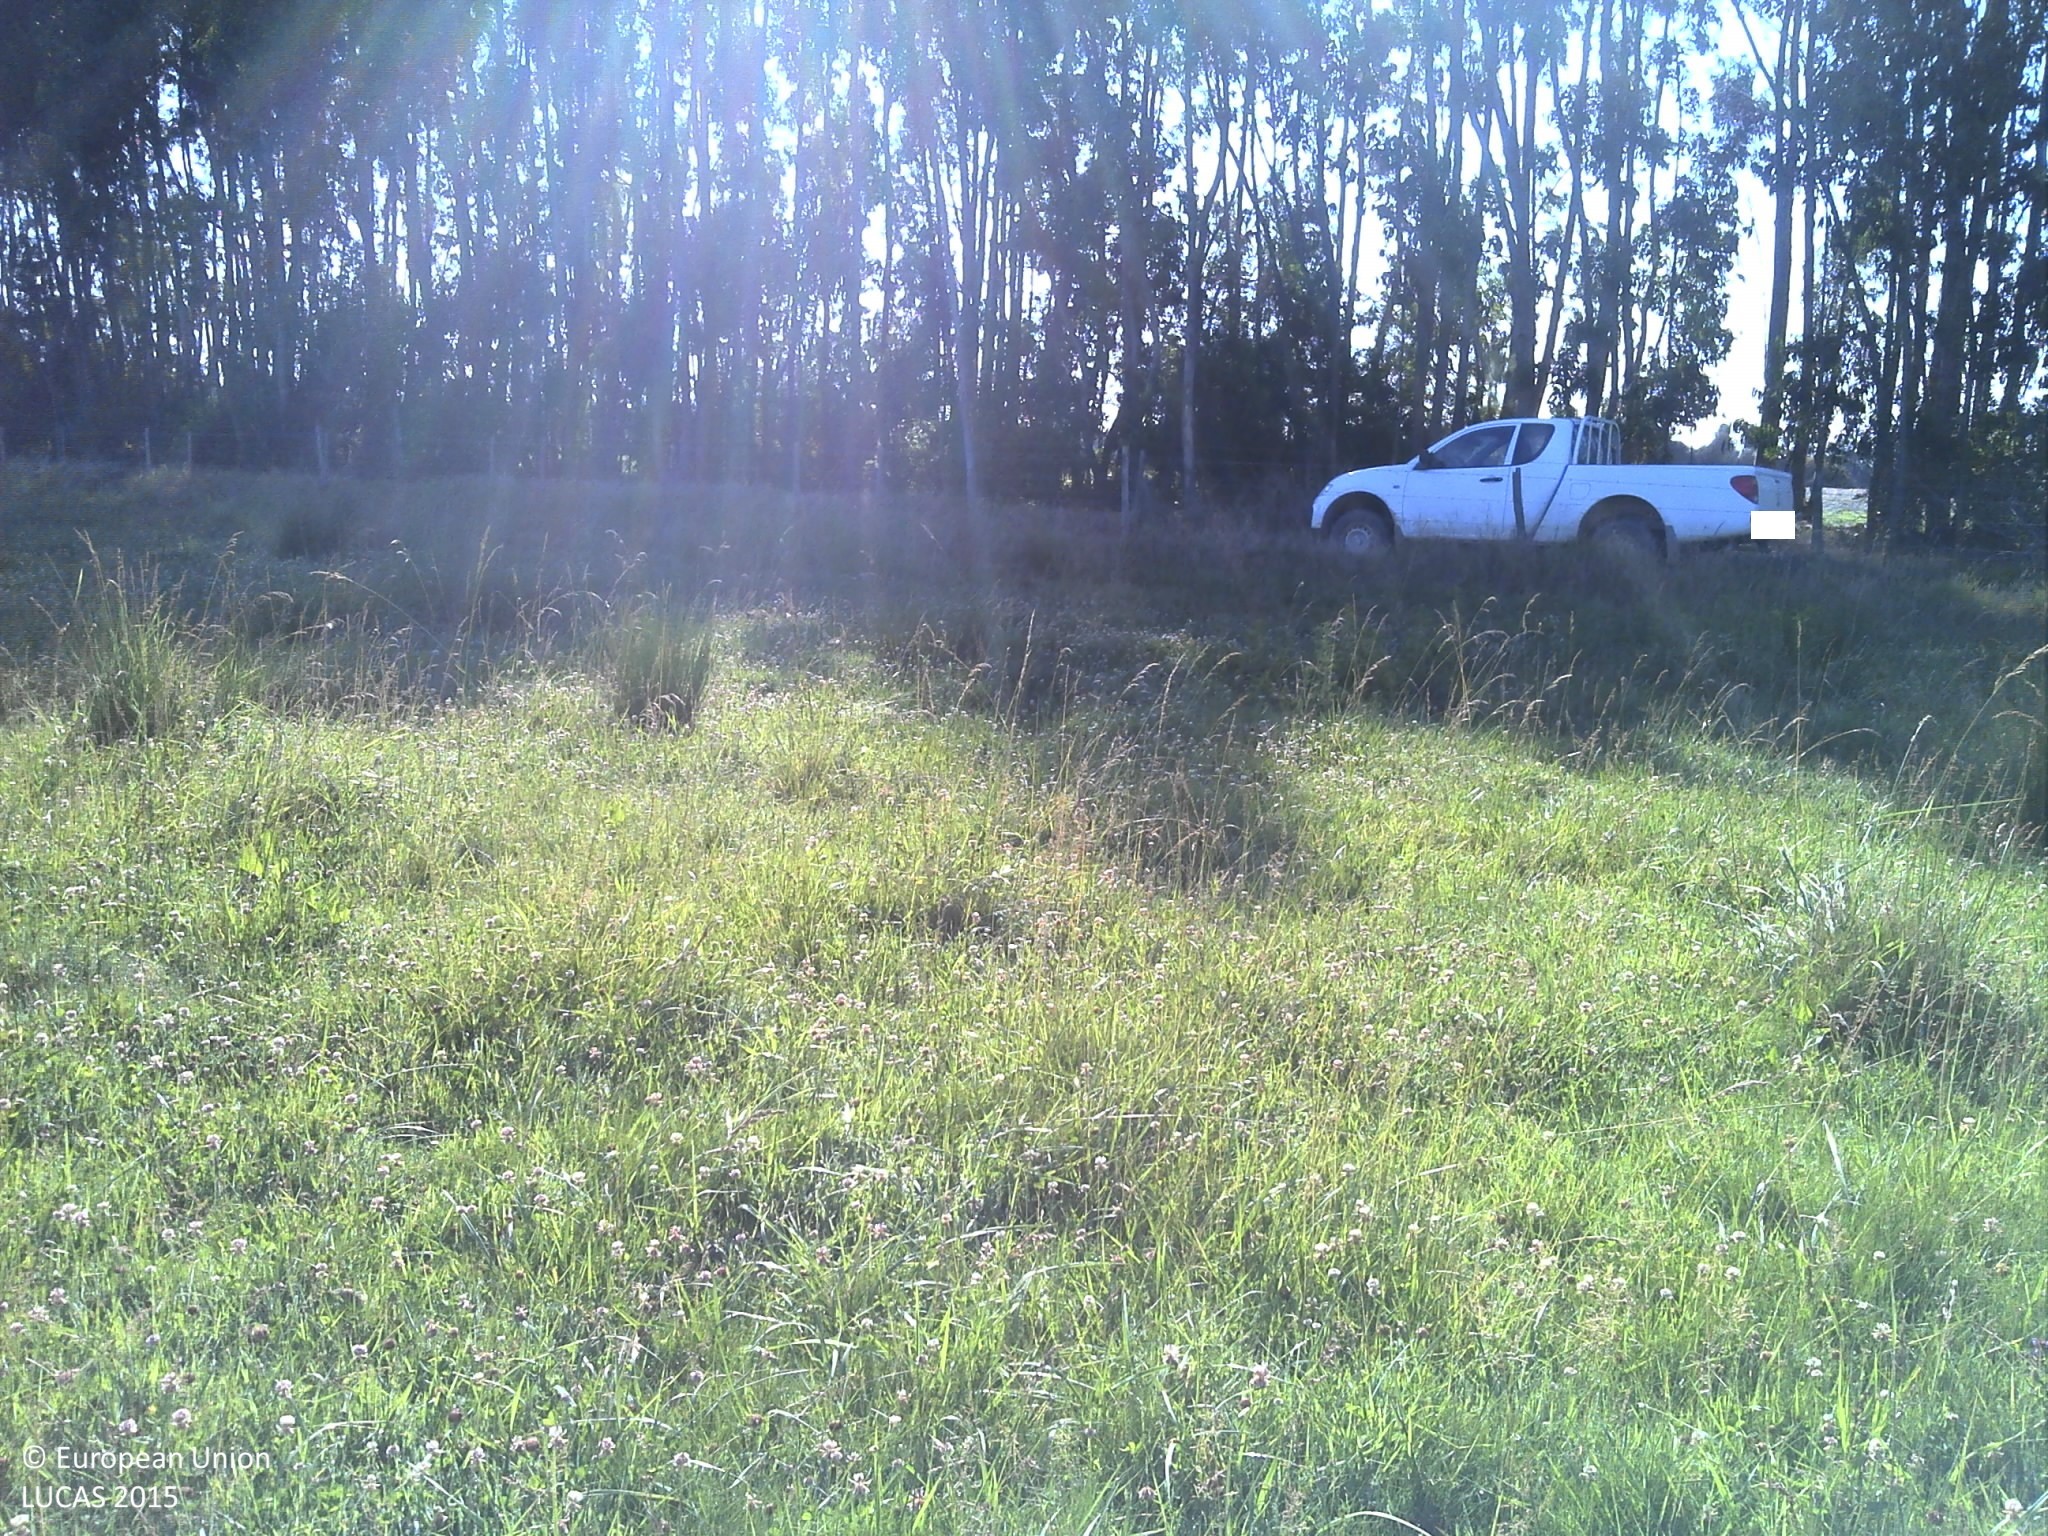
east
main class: Cropland
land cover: Temporary grasslands
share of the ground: > 75 %
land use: Agriculture (excluding fallow land and kitchen gardens)
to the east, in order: Temporary grasslands; Fences; Tracks; Fences; Broadleaved woodland; Fences; Temporary grasslands; Fences; Shruby margins; Grassland without tree/shrub cover
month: June
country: PT
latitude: 37.4772
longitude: -8.7533
